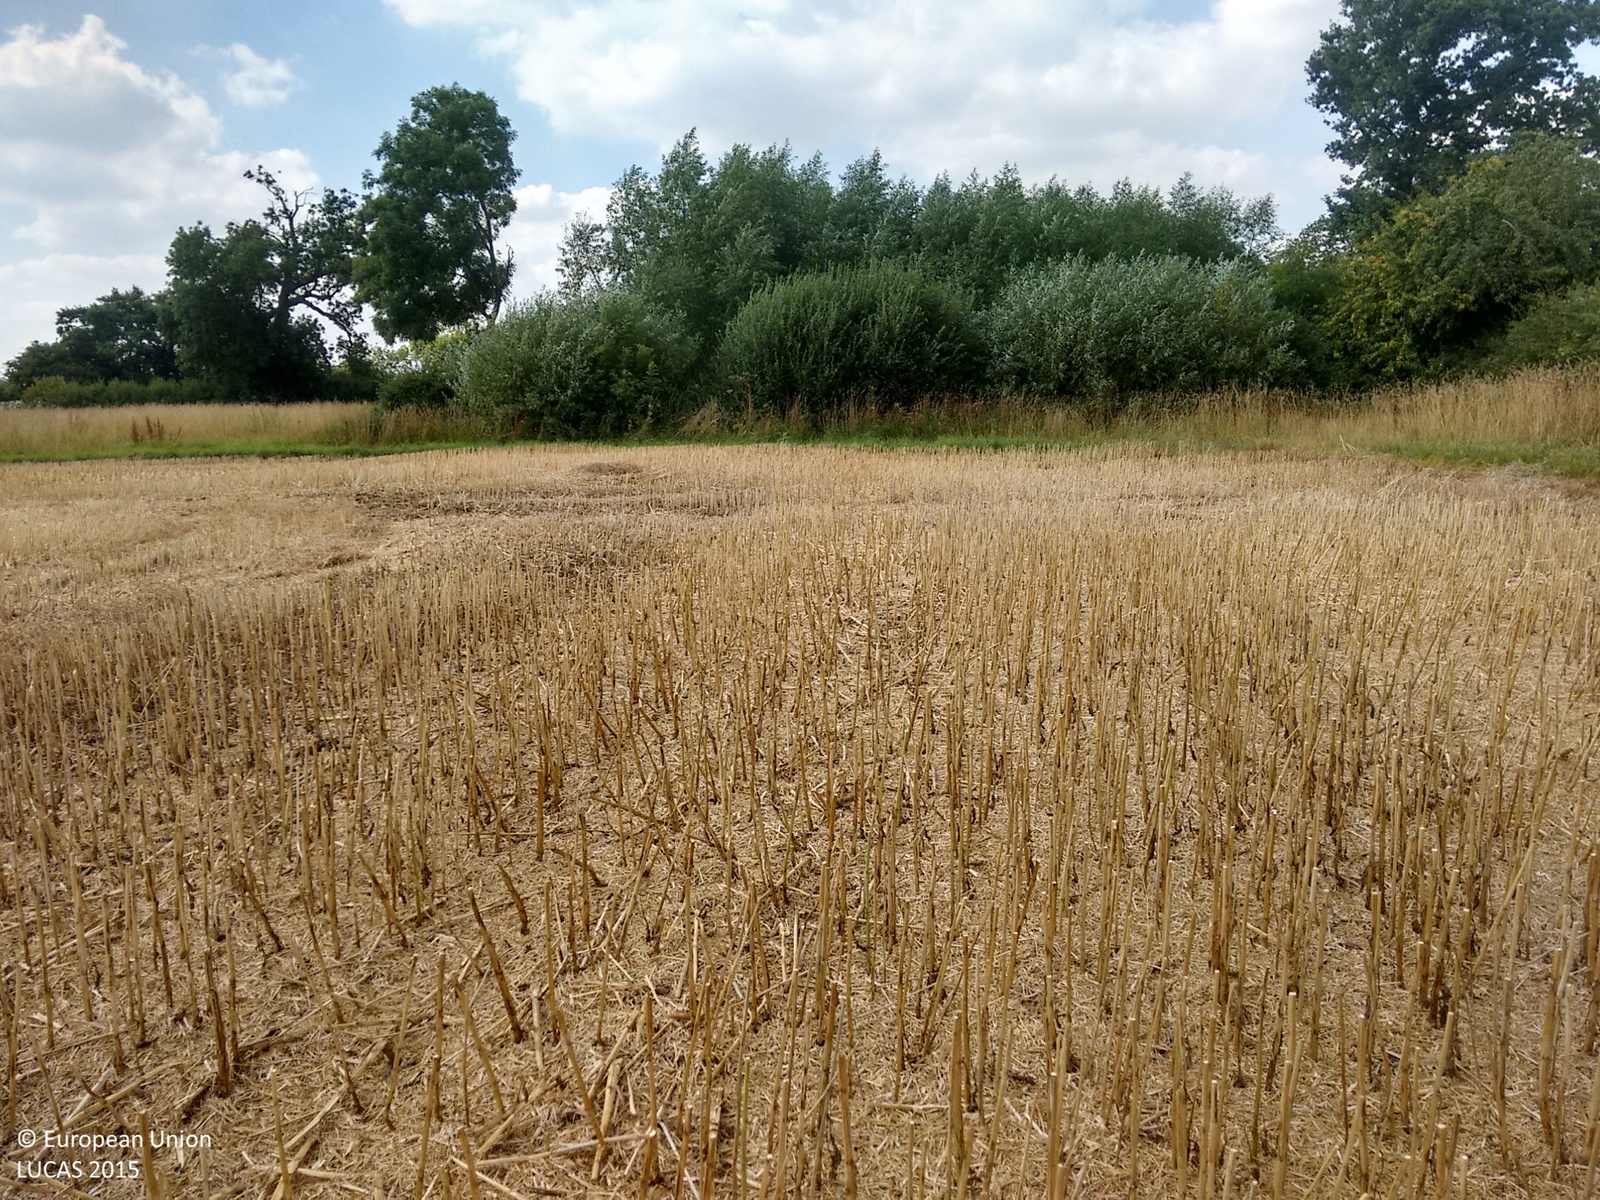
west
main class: Cropland
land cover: Rape and turnip rape
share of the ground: > 75 %
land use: Agriculture (excluding fallow land and kitchen gardens)
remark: Harvested field
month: August
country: GB
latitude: 52.6011
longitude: -1.4635
